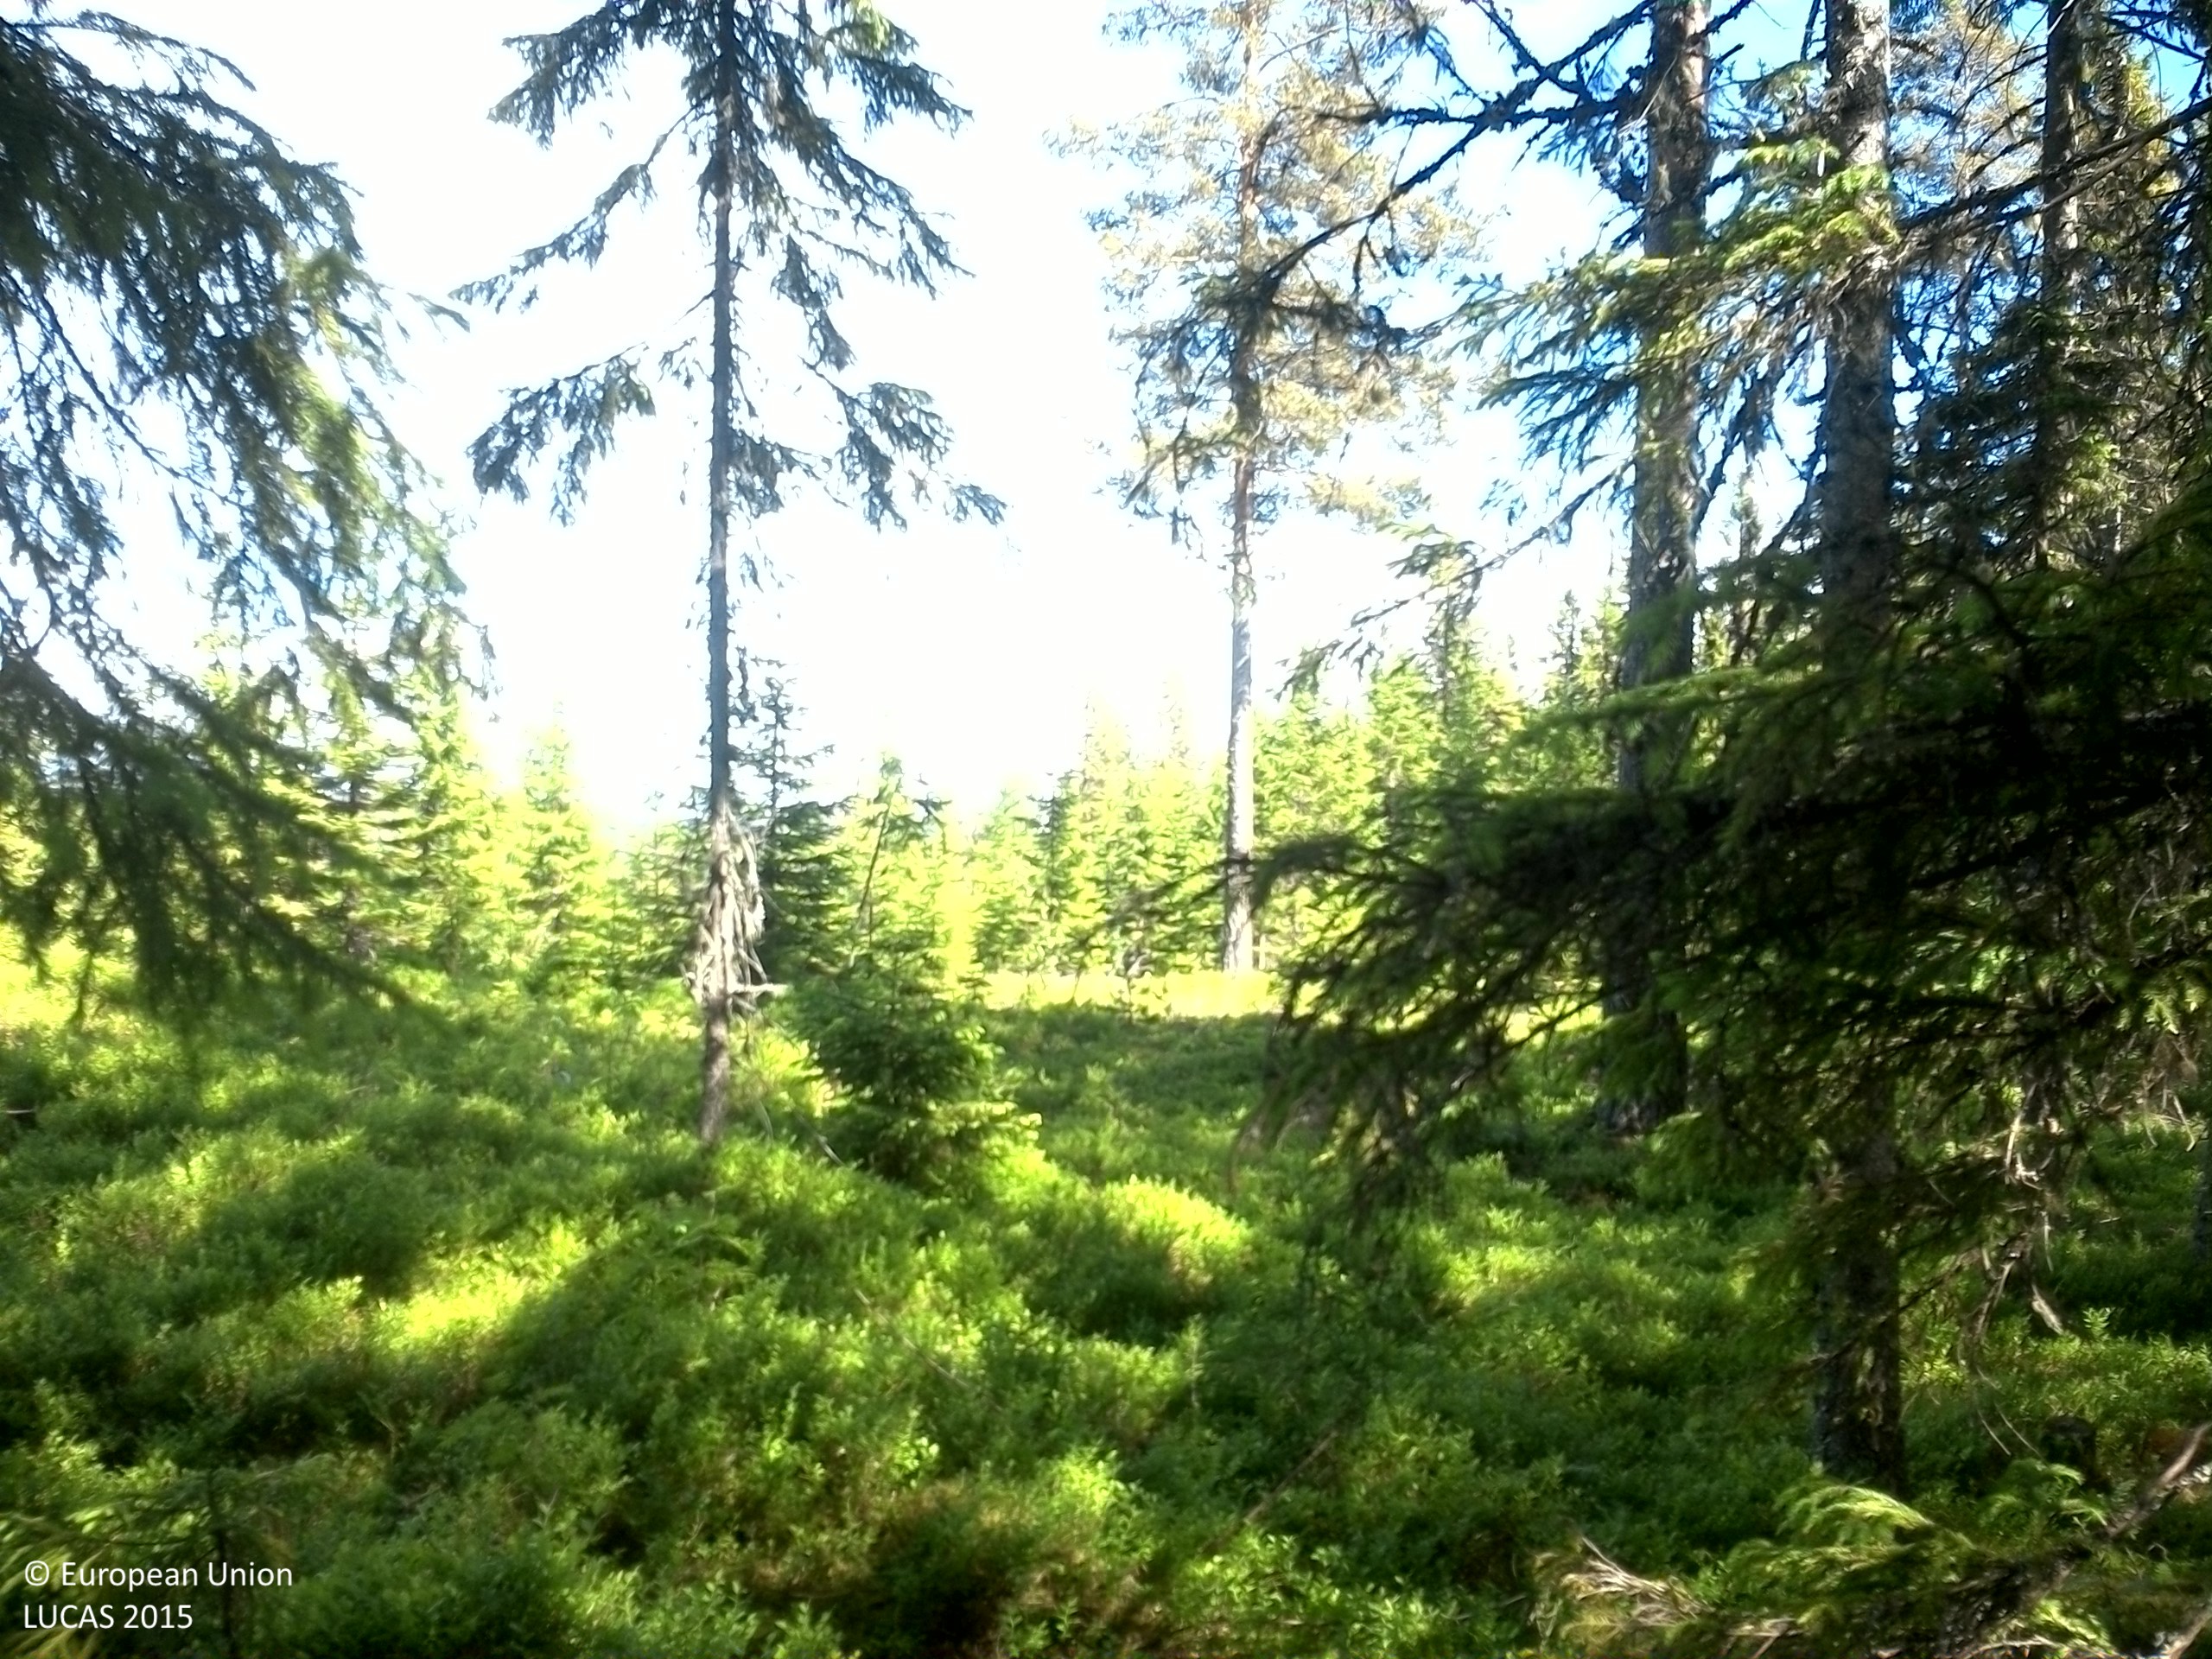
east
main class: Woodland
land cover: Spruce dominated coniferous woodland
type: boreal forest
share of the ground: 50 - 75 %
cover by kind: coniferous forest trees 60 %, shrubs 30 %, broadleaved forest trees 10 %
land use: Forestry
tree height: > 5 m
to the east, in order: Spruce dominated coniferous woodland; Pine dominated coniferous woodland; Spruce dominated coniferous woodland; Pine dominated coniferous woodland
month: June
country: SE
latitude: 62.8485
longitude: 17.7371
